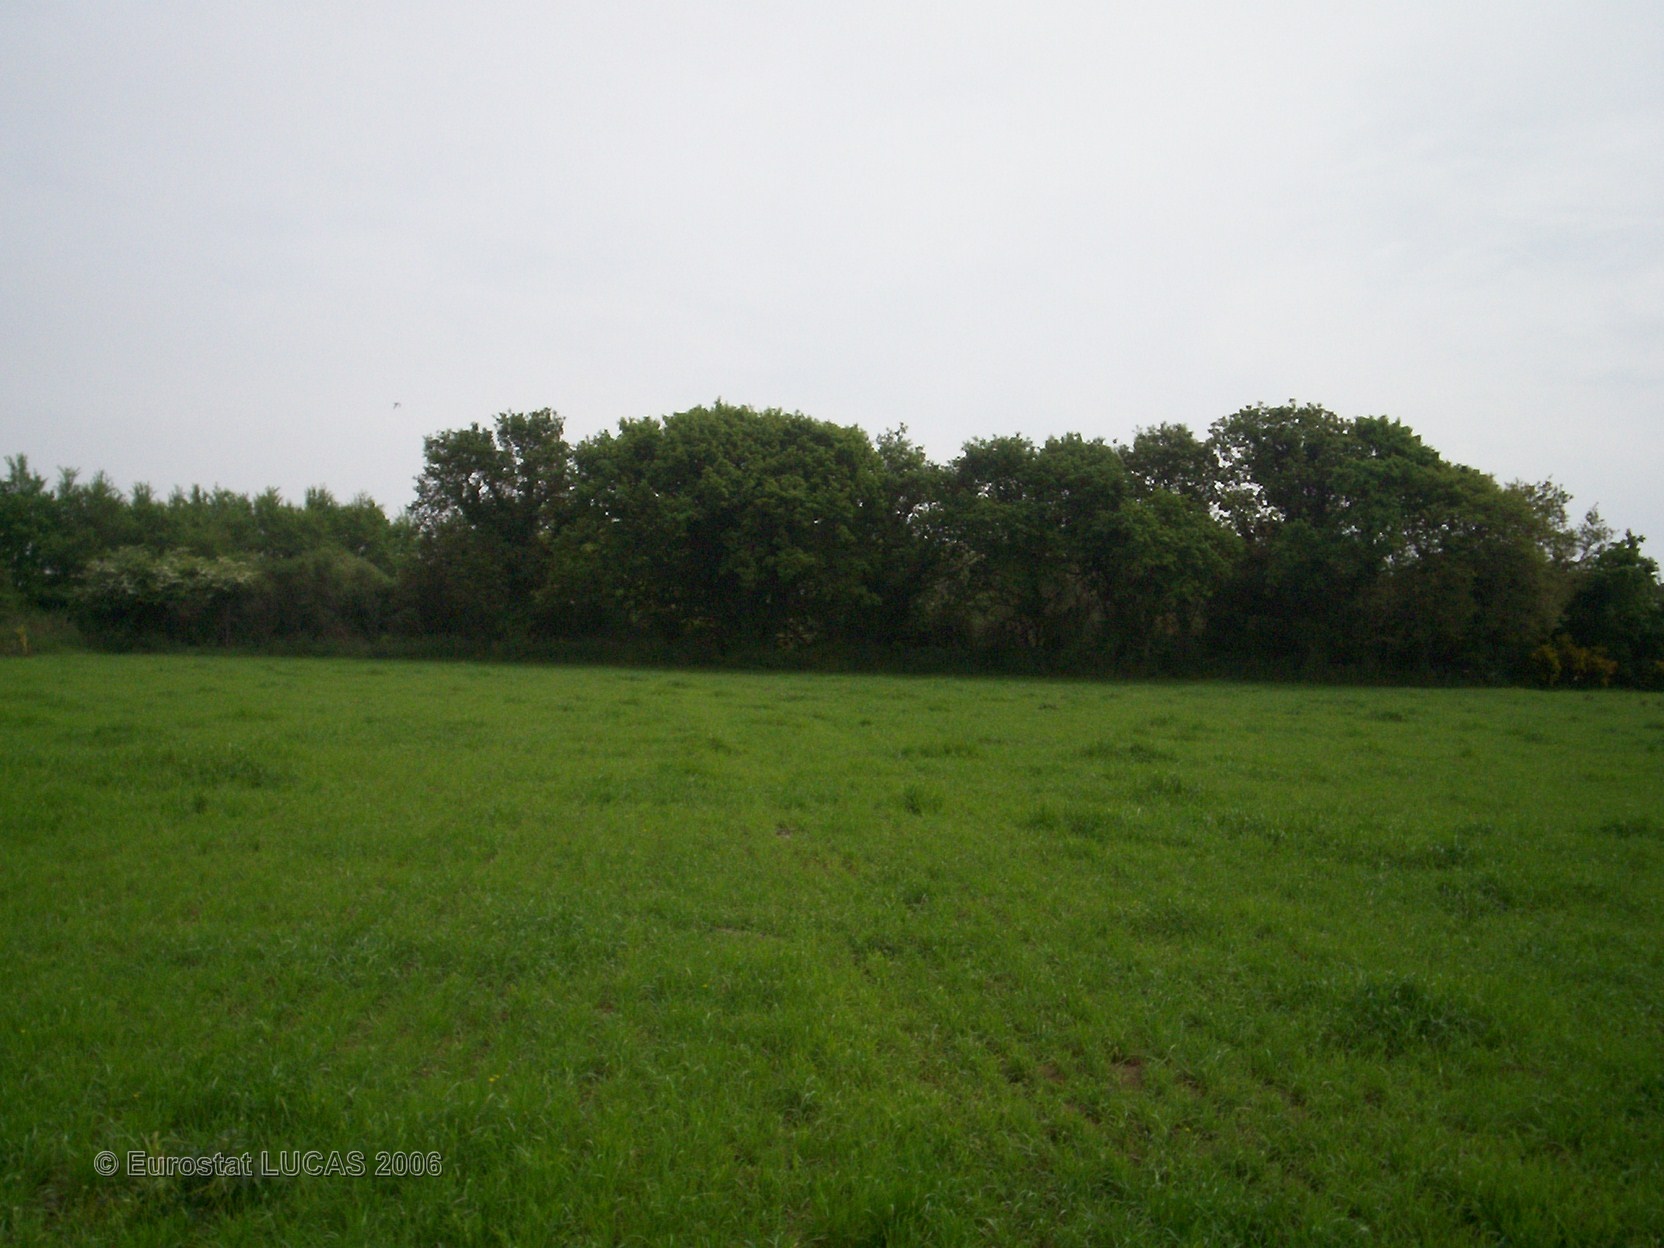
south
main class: Grassland
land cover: Grassland without tree/shrub cover
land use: Agriculture (excluding fallow land and kitchen gardens)
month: May
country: FR
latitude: 47.8184
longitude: -3.8522
